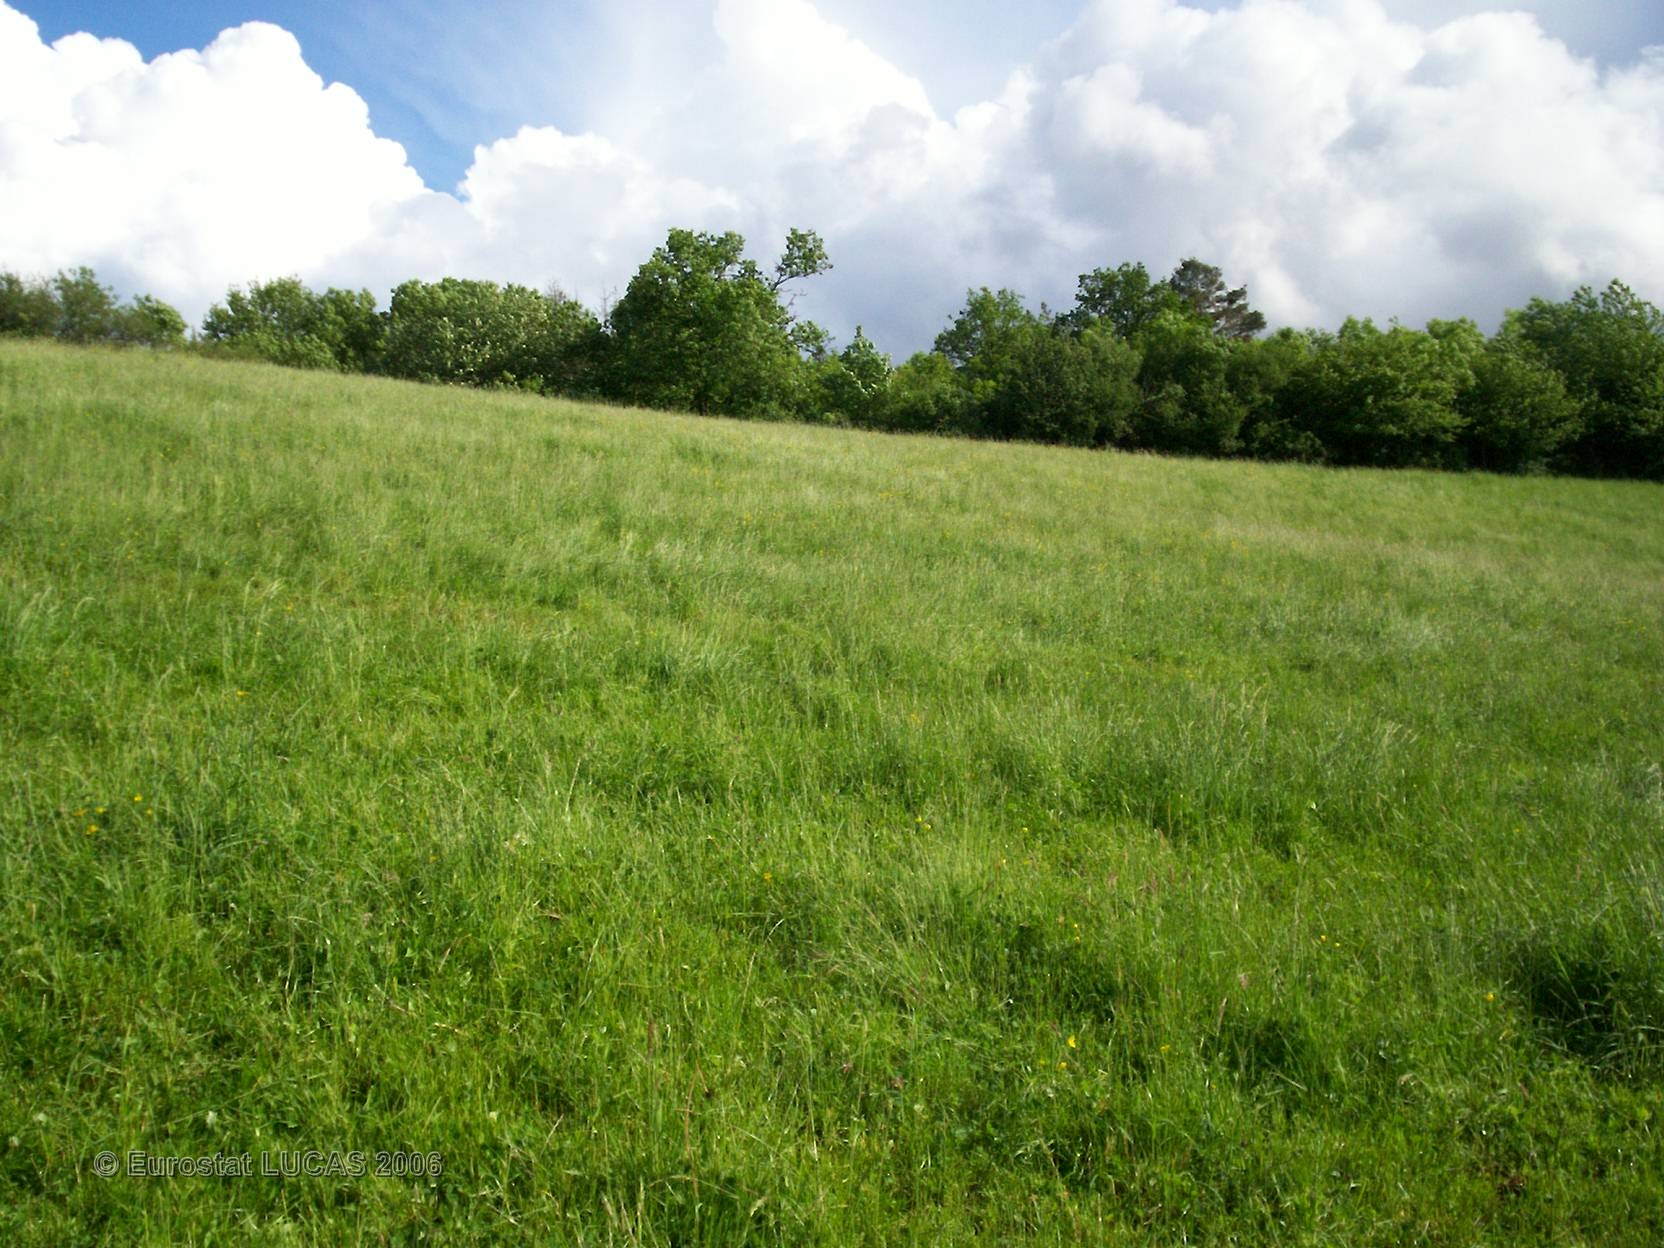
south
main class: Grassland
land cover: Grassland without tree/shrub cover
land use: Agriculture (excluding fallow land and kitchen gardens)
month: May
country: FR
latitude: 48.3079
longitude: 6.9672
